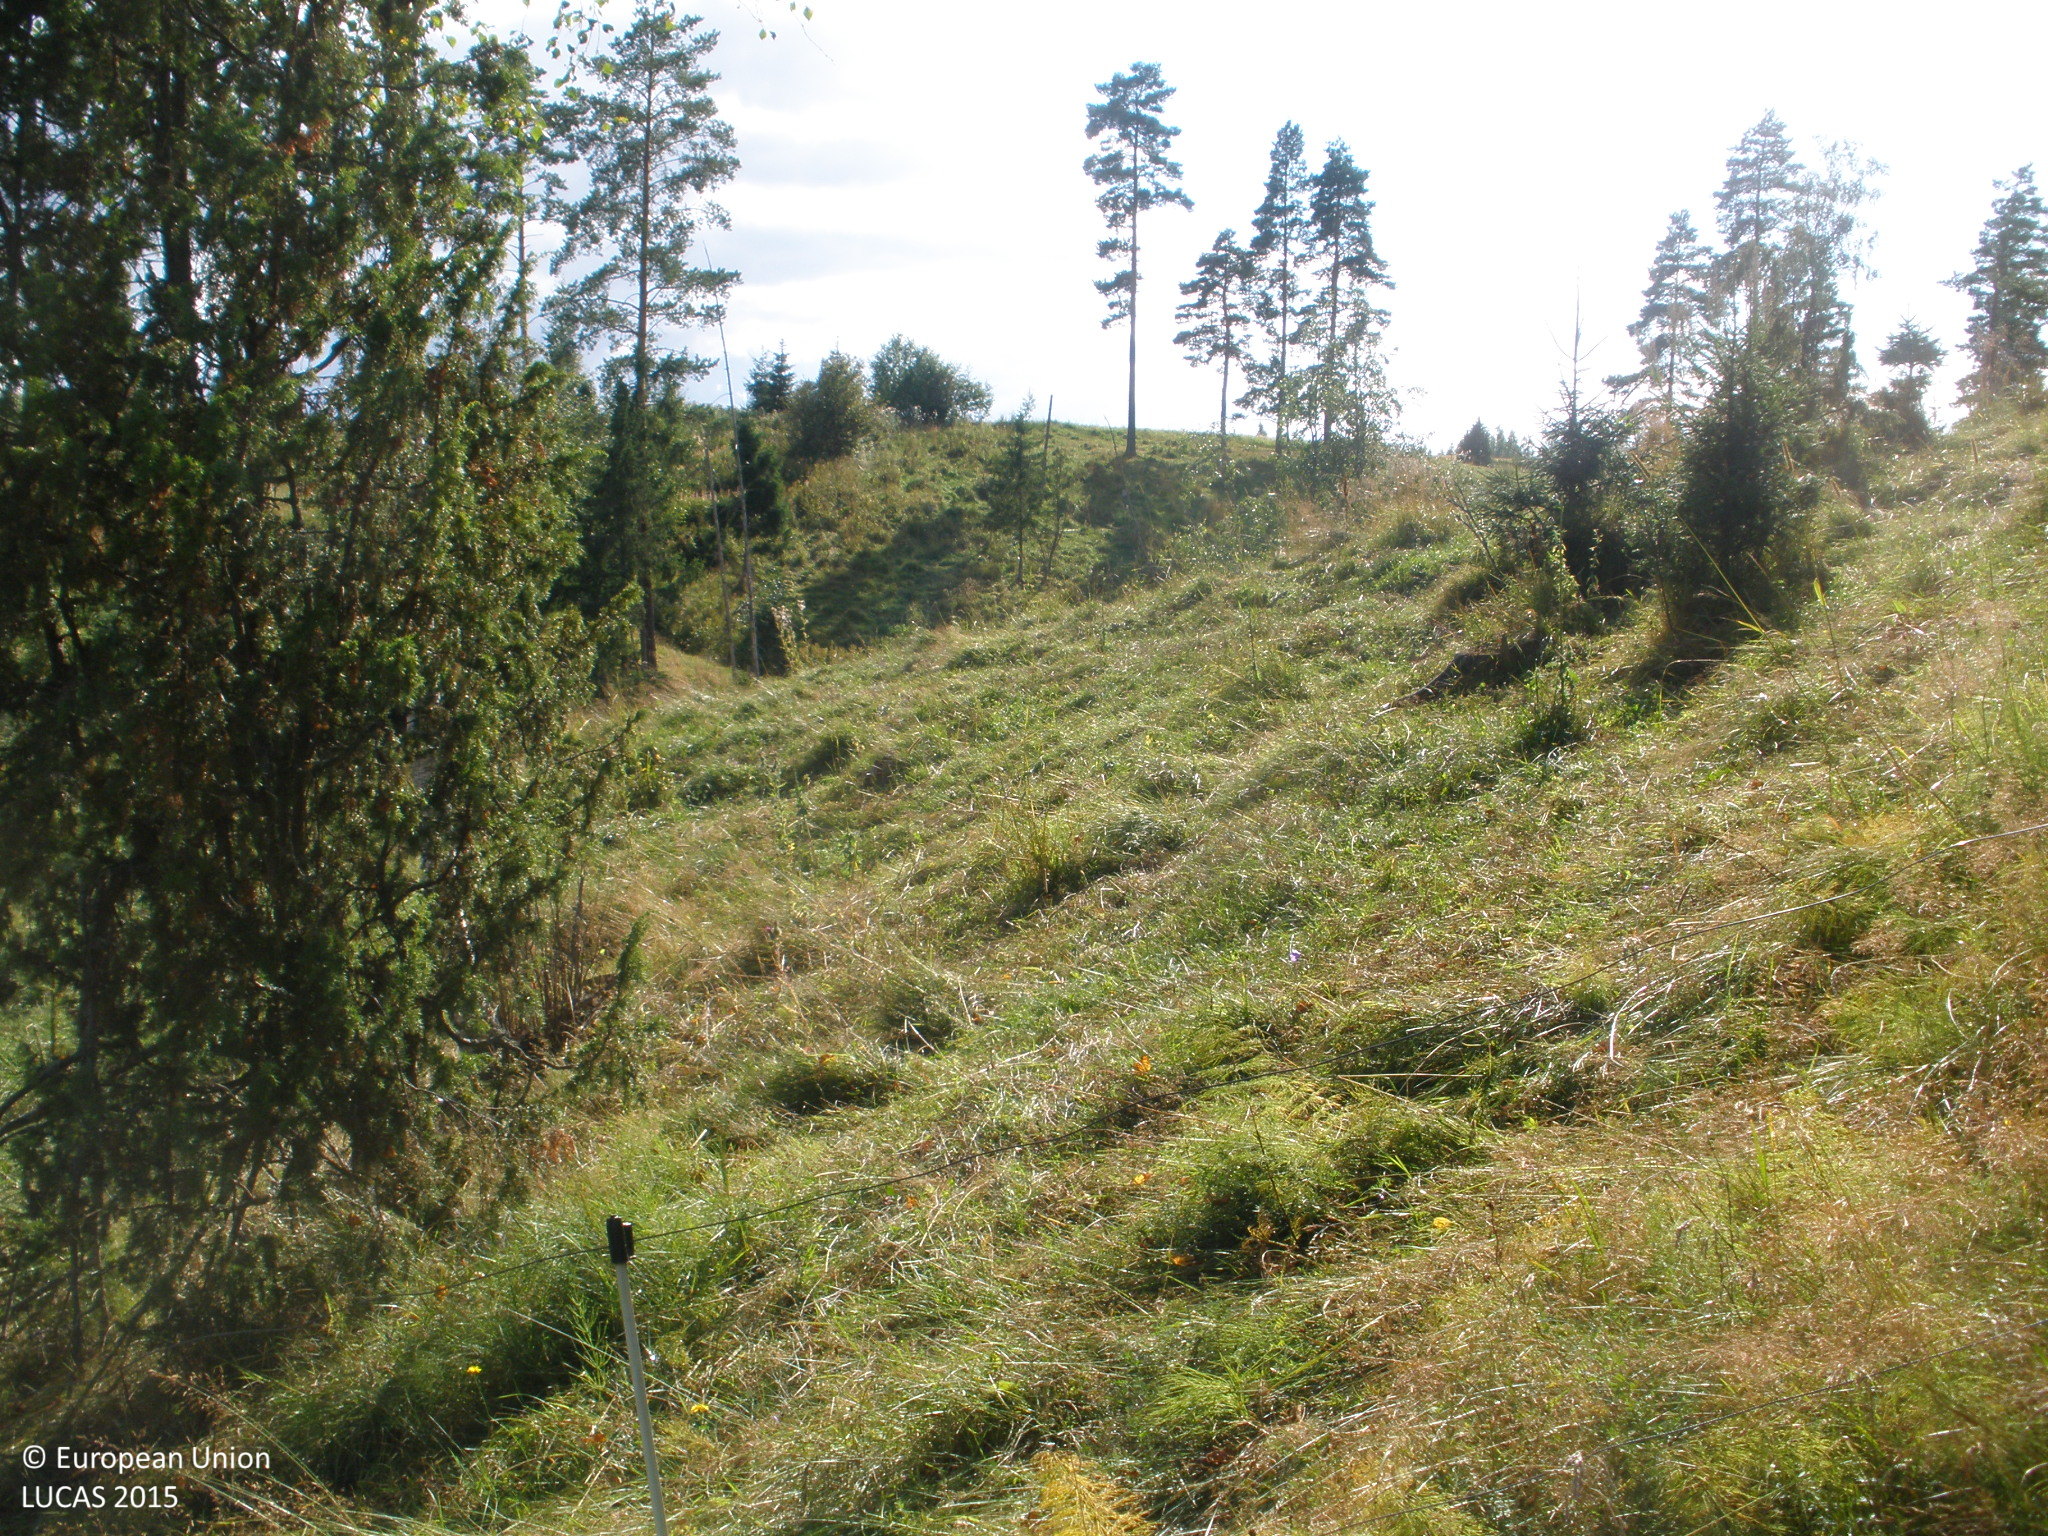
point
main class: Grassland
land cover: Grassland with sparse tree/shrub cover
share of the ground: > 75 %
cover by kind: herbaceous plants 85 %, broadleaved forest trees 5 %, shrubs 5 %, unconsolidated bare surface 5 %
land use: Agriculture (excluding fallow land and kitchen gardens)
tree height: < 5 m
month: August
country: FI
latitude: 60.6027
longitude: 23.3609
